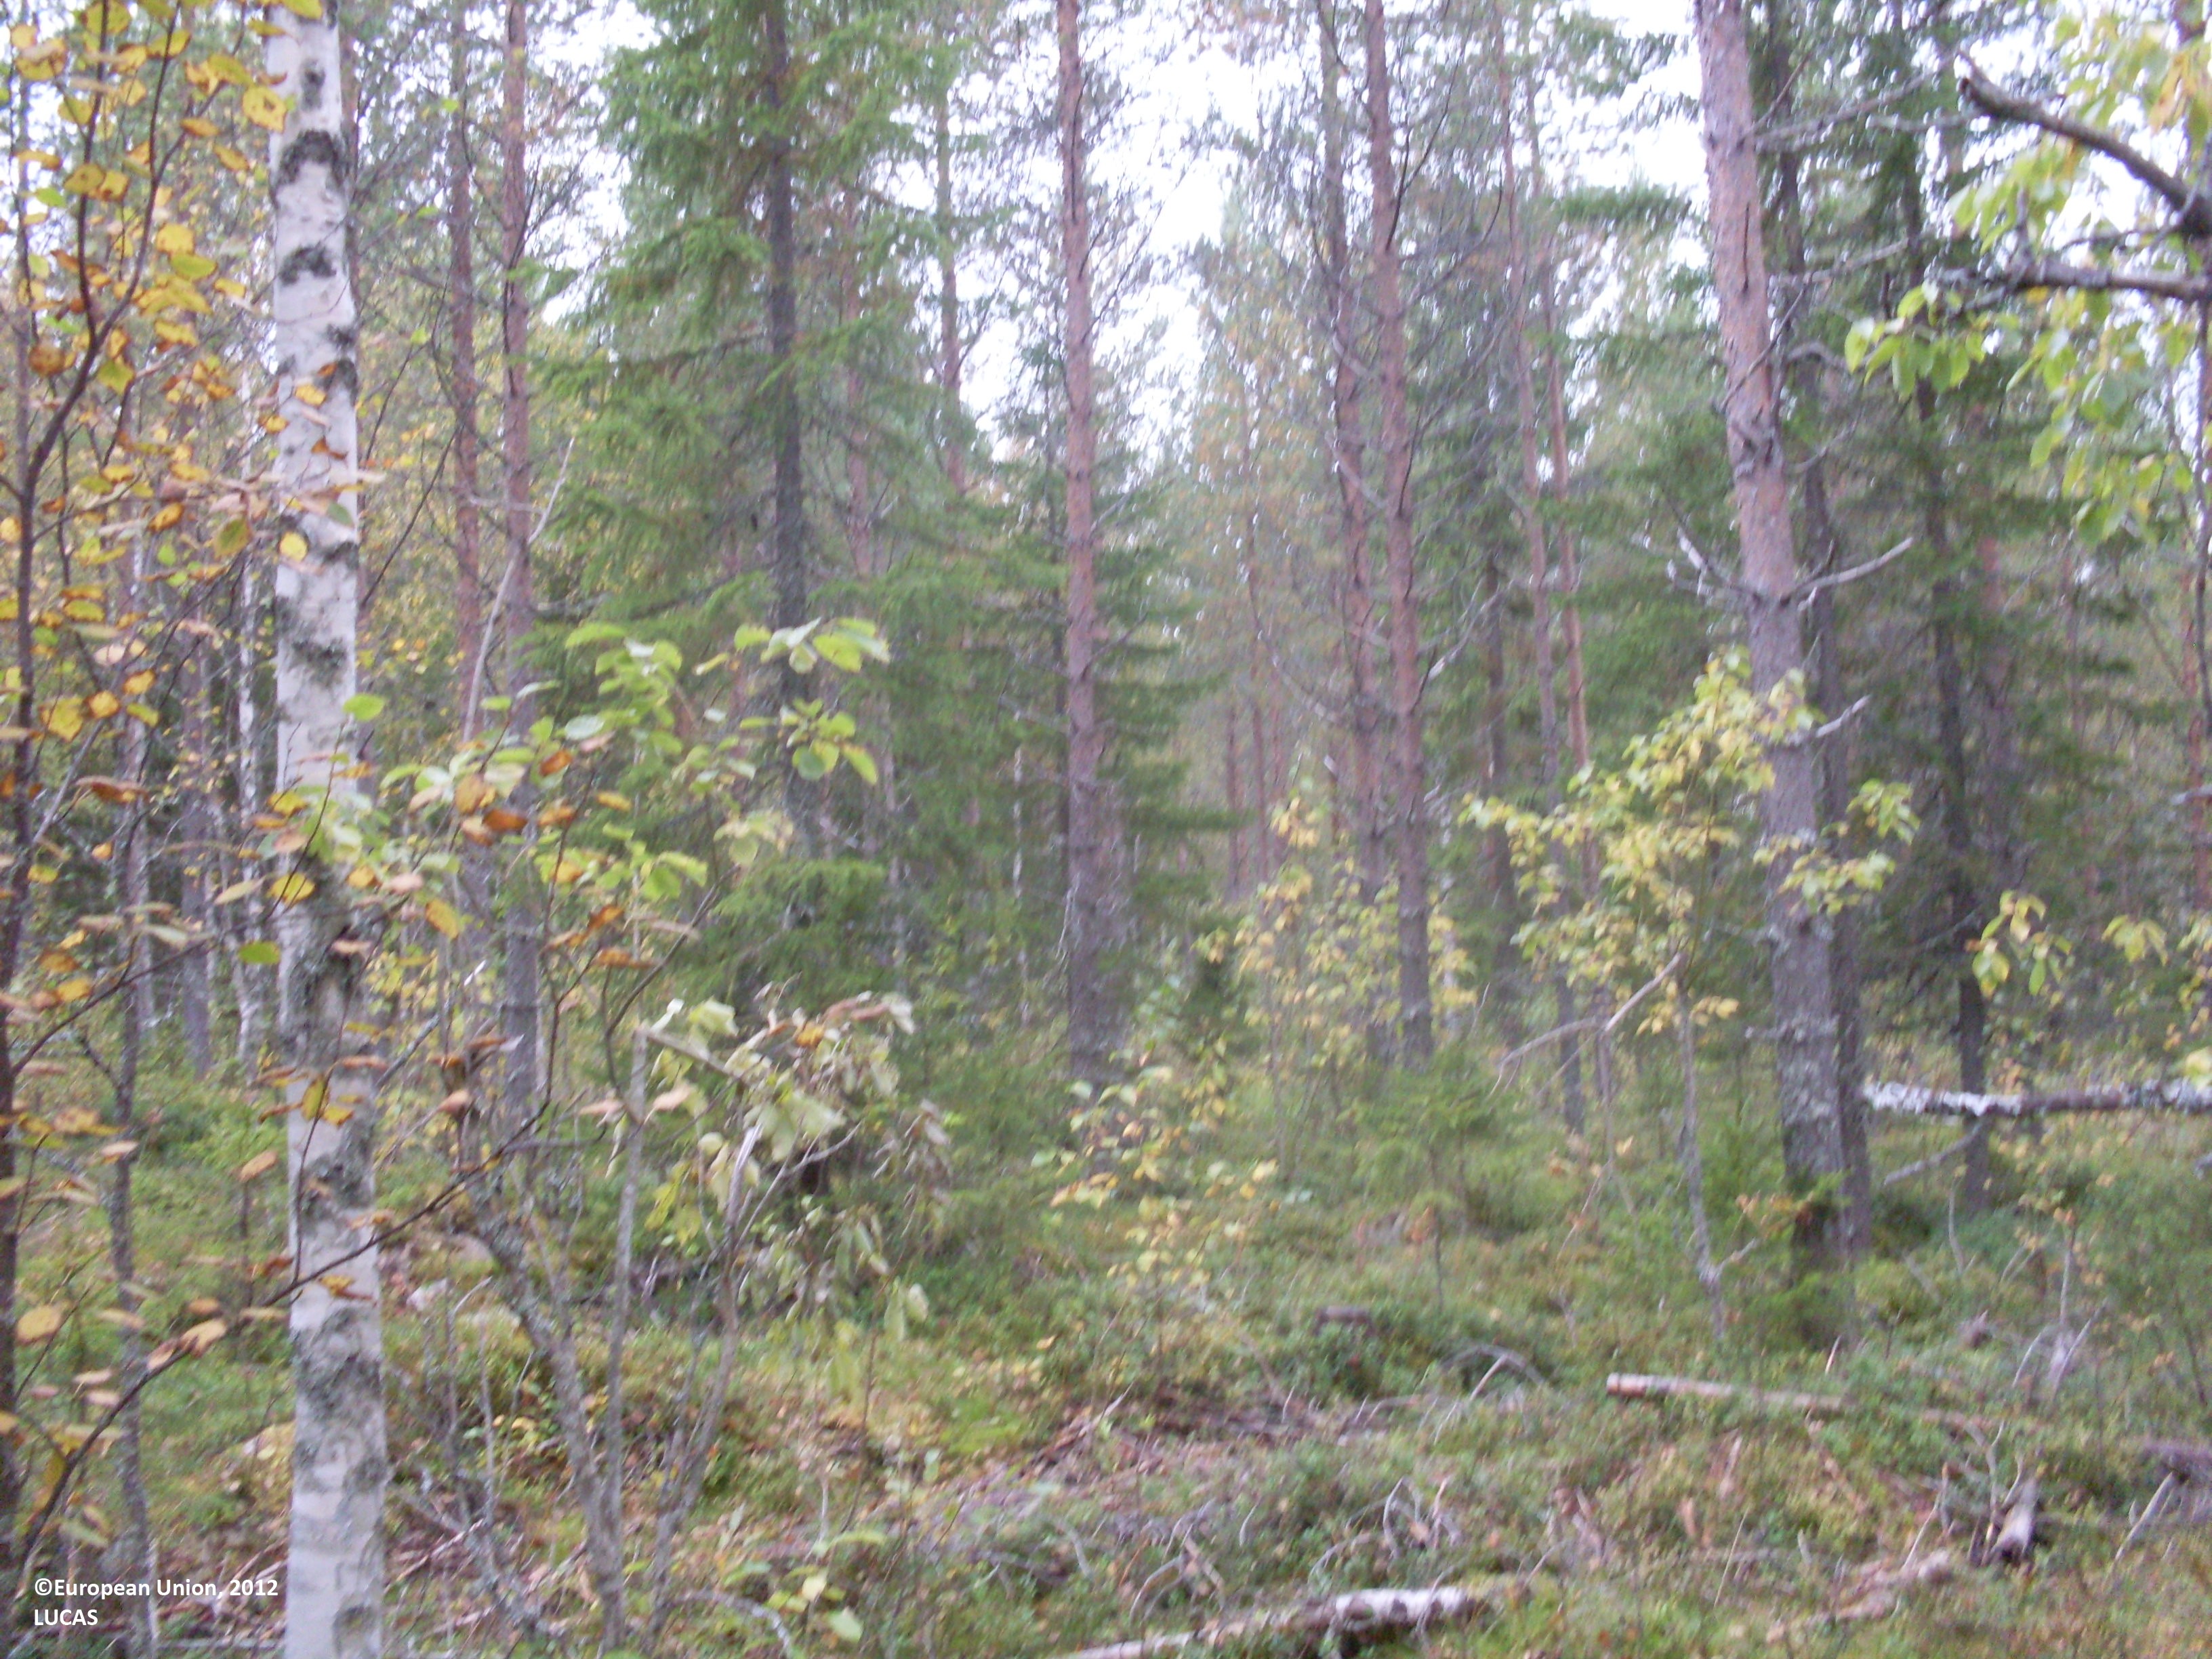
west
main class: Woodland
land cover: Other mixed woodland
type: boreal forest
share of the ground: > 75 %
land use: Forestry
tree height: > 5 m
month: September
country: FI
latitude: 63.9992
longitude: 29.8841
